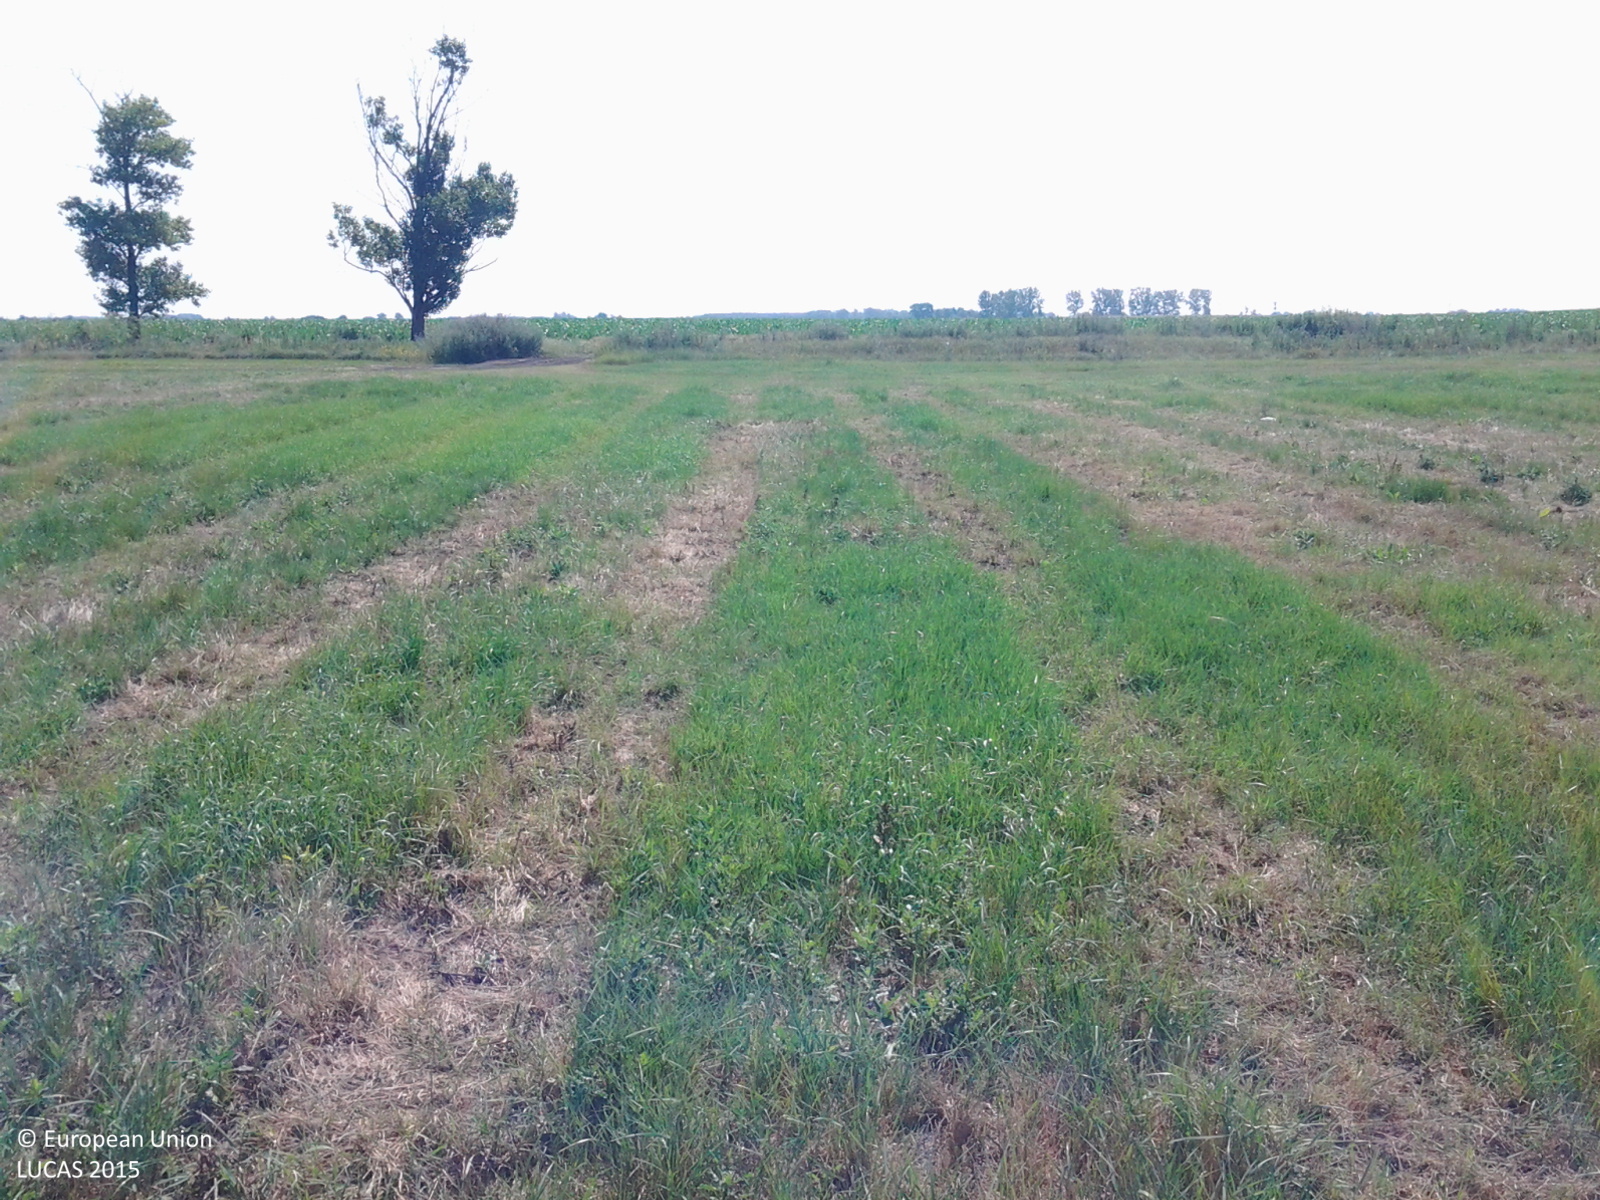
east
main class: Grassland
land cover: Grassland without tree/shrub cover
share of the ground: > 75 %
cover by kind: herbaceous plants 100 %
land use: Agriculture (excluding fallow land and kitchen gardens)
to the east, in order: Grassland without tree/shrub cover; Electric lines; Grassland without tree/shrub cover; Ditches and canals; Shruby margins; Tracks; Shruby margins; Ditches and canals; Shruby margins; Maize
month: July
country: HU
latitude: 47.6614
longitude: 19.9734
